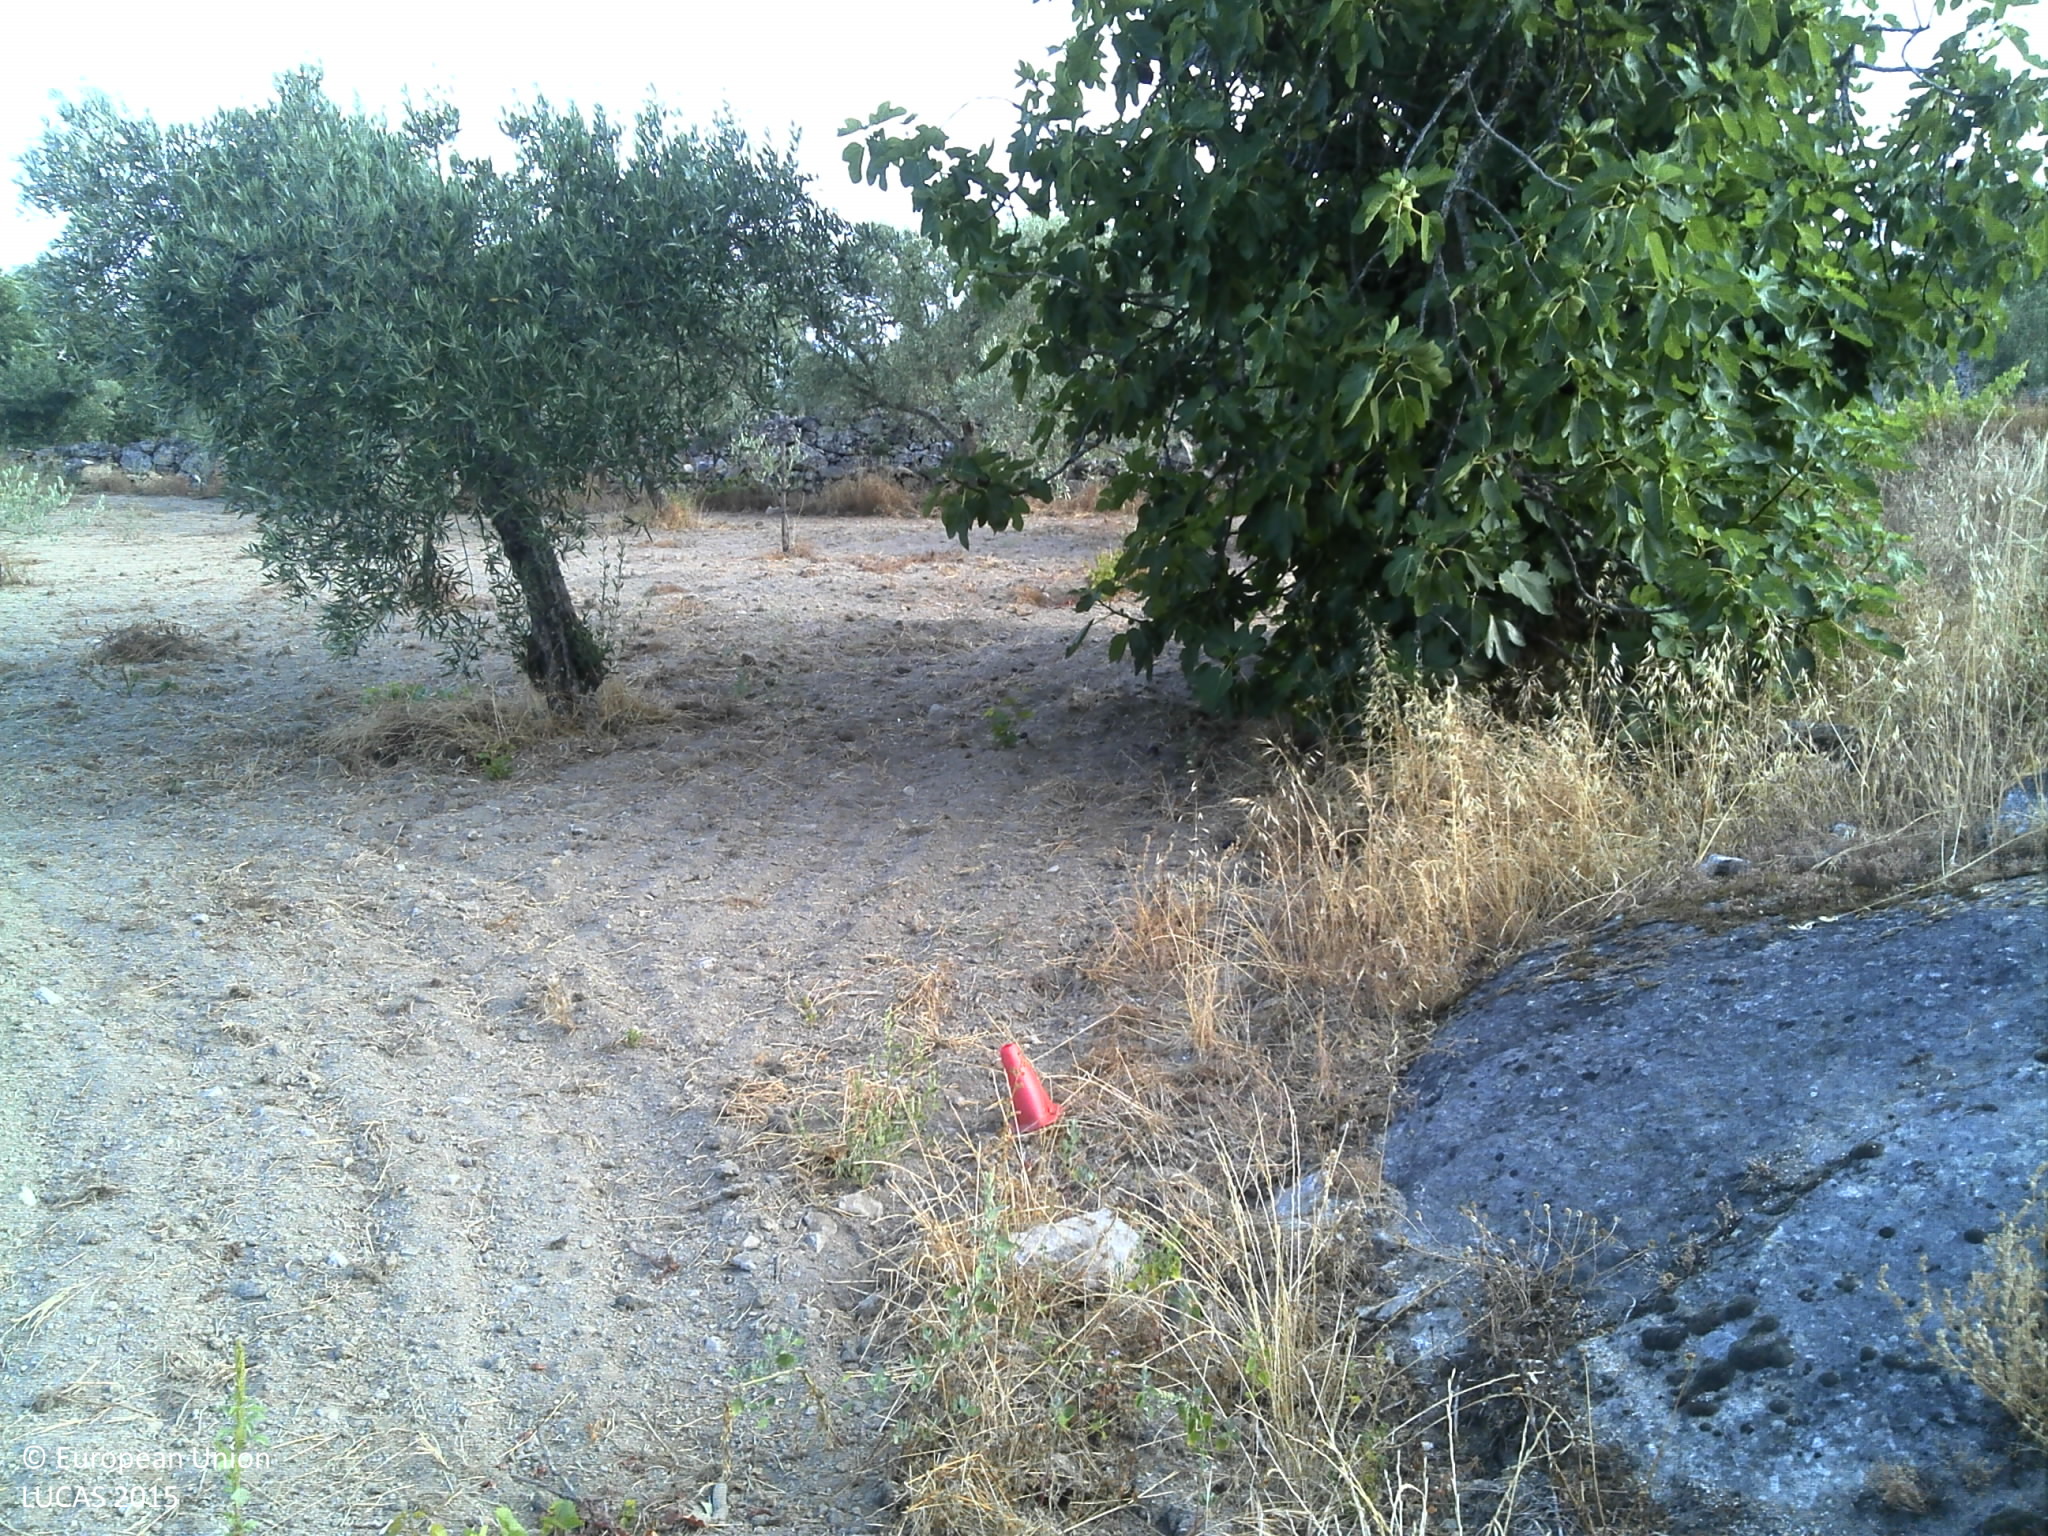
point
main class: Cropland
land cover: Olive groves
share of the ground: 25 - 50 %
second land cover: Other bare soil
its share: > 75 %
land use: Agriculture (excluding fallow land and kitchen gardens)
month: July
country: PT
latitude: 40.9641
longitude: -7.5266
